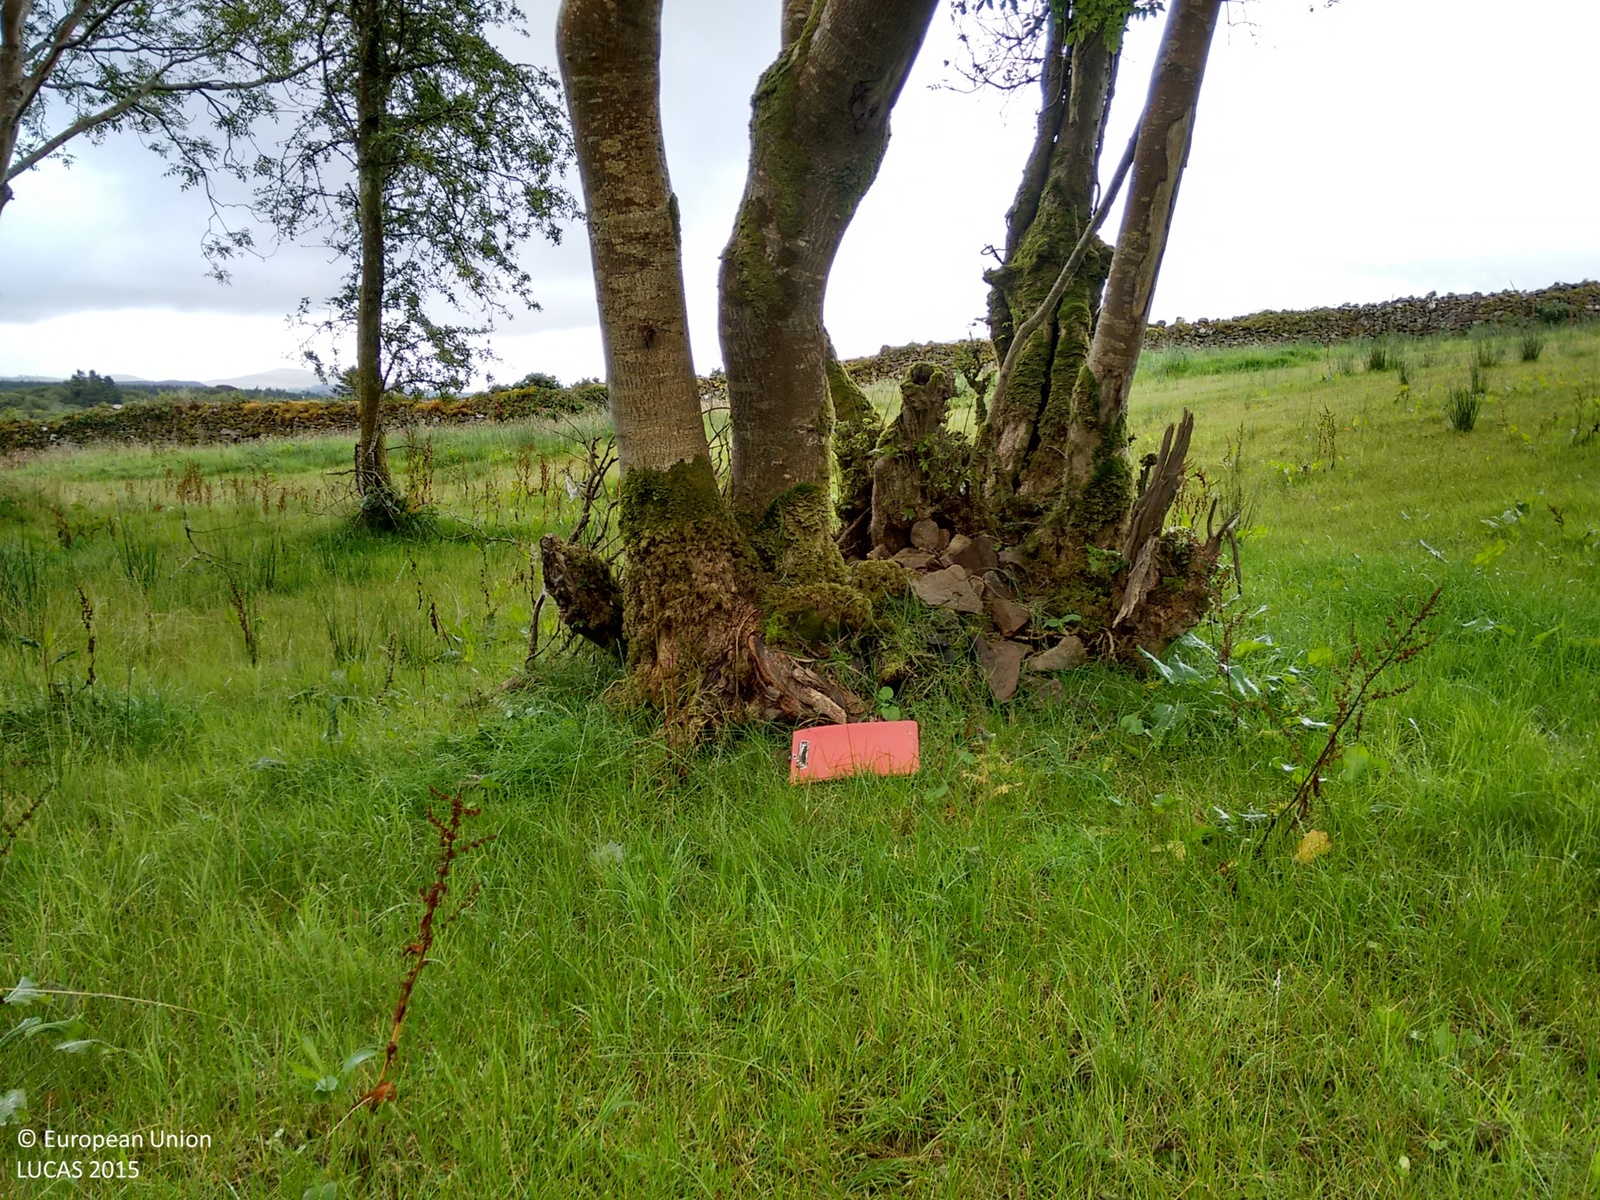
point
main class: Woodland
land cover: Broadleaved woodland
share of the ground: > 75 %
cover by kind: broadleaved forest trees 75 %, herbaceous plants 25 %
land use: Agriculture (excluding fallow land and kitchen gardens)
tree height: < 5 m
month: September
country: IE
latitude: 54.0159
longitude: -9.2844
